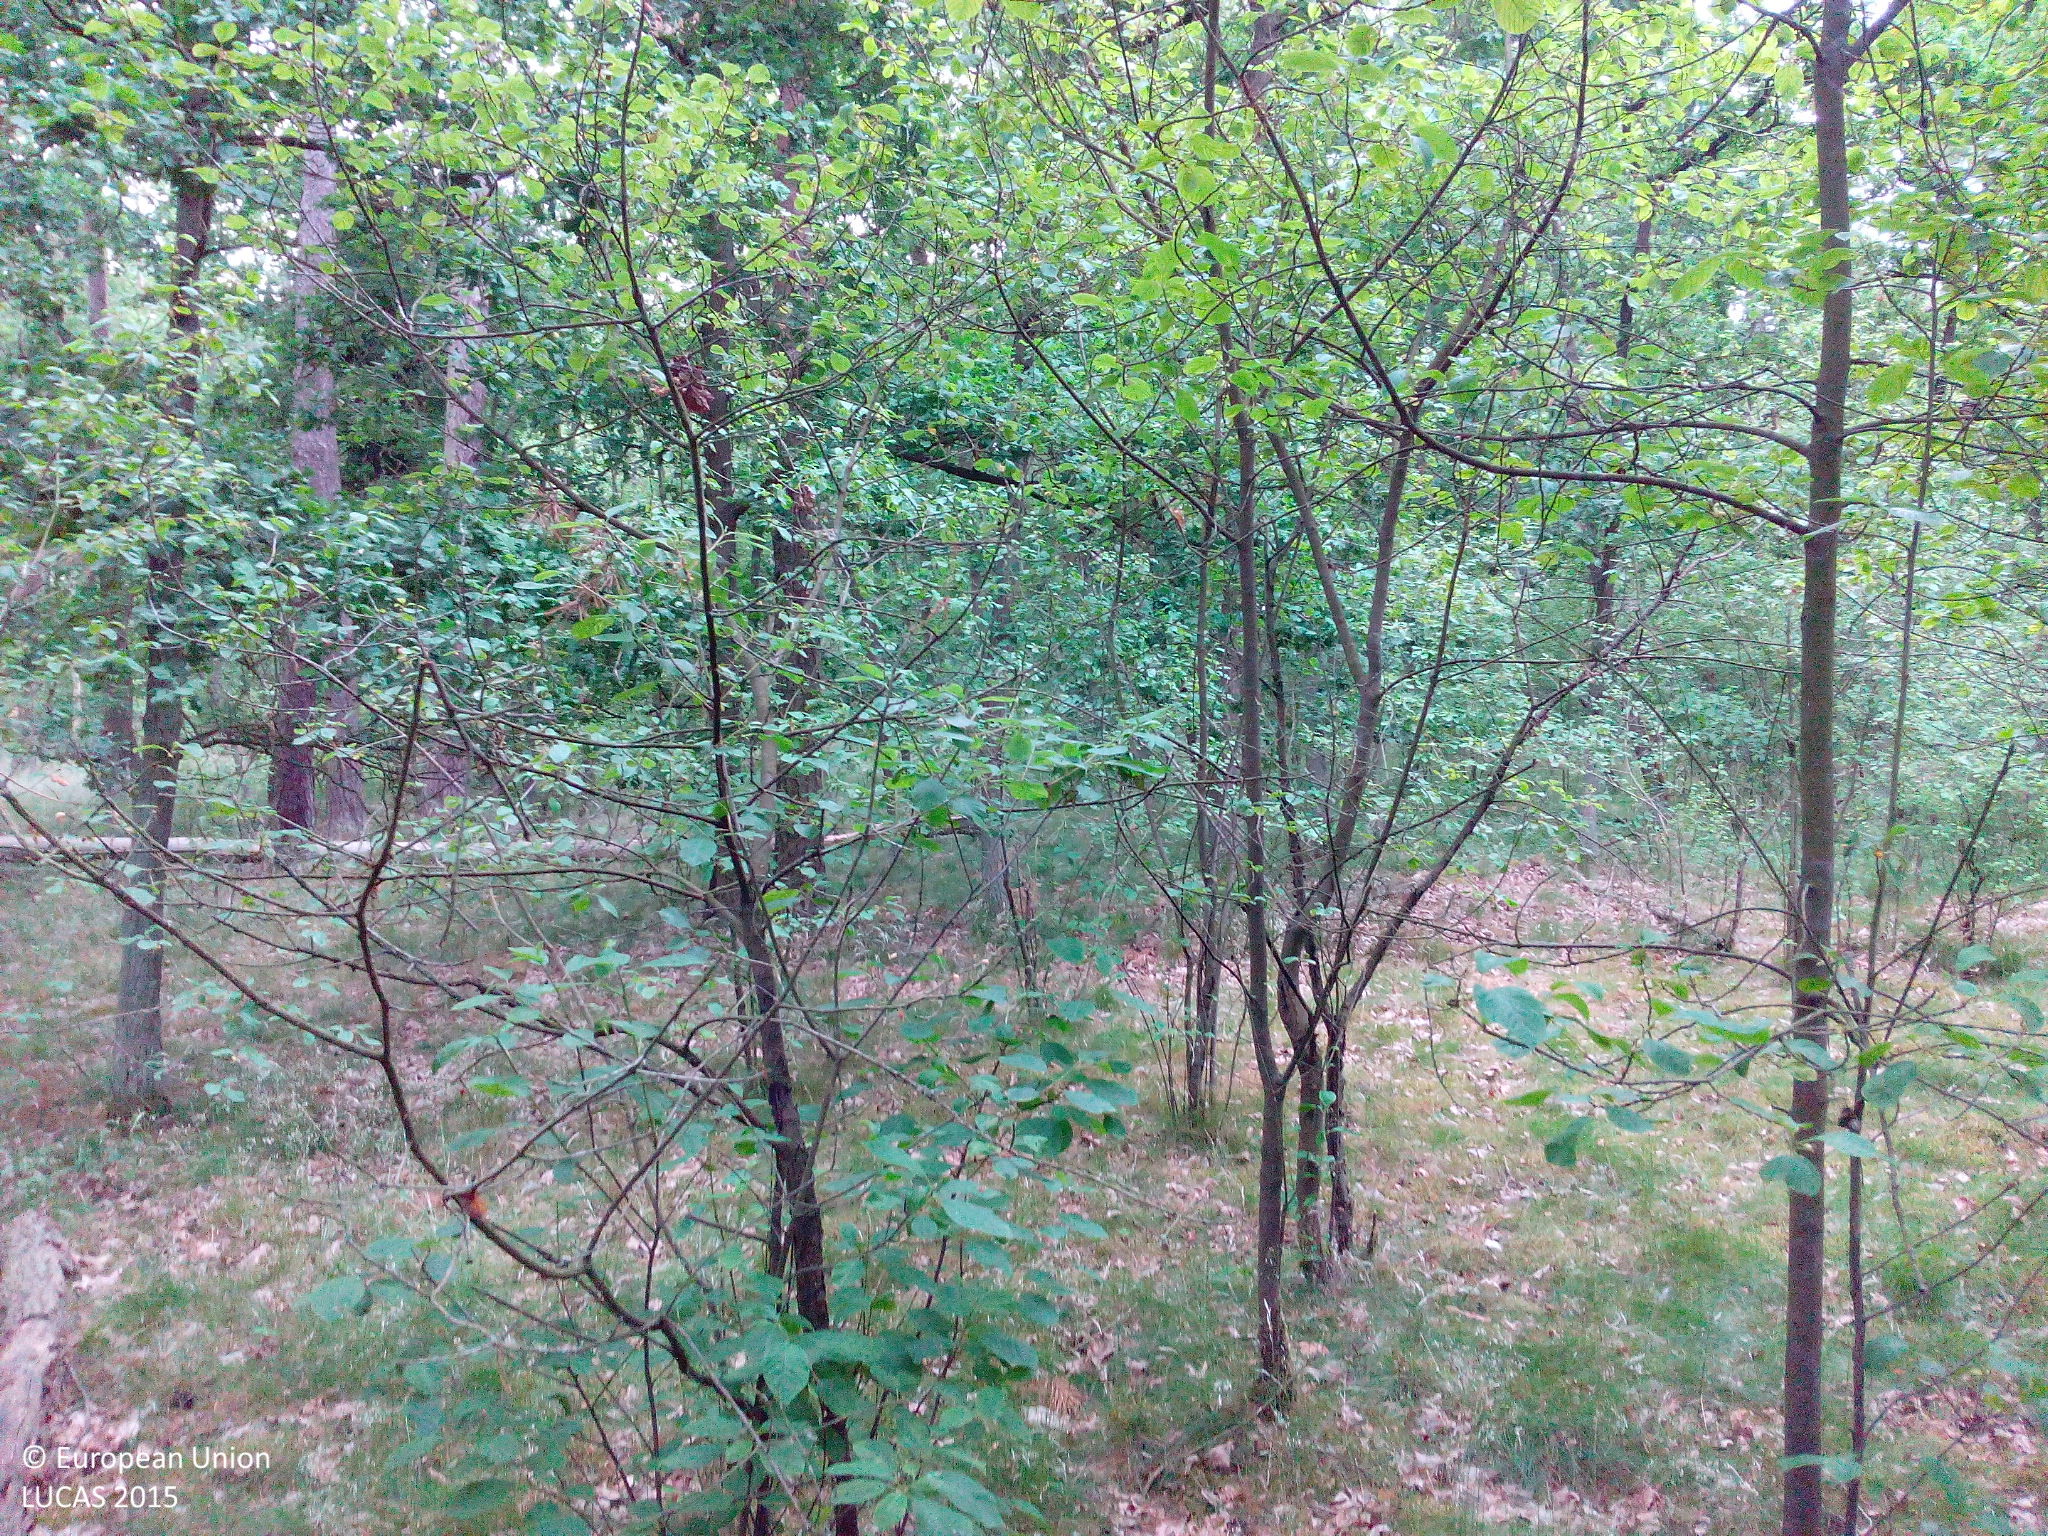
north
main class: Woodland
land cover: Broadleaved woodland
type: mesophytic deciduous forest
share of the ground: > 75 %
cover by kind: broadleaved forest trees 80 %, herbaceous plants 10 %, lichens and mosses 5 %, unconsolidated bare surface 5 %
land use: Forestry
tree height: > 5 m
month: June
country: DE
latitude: 53.1915
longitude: 11.7505
